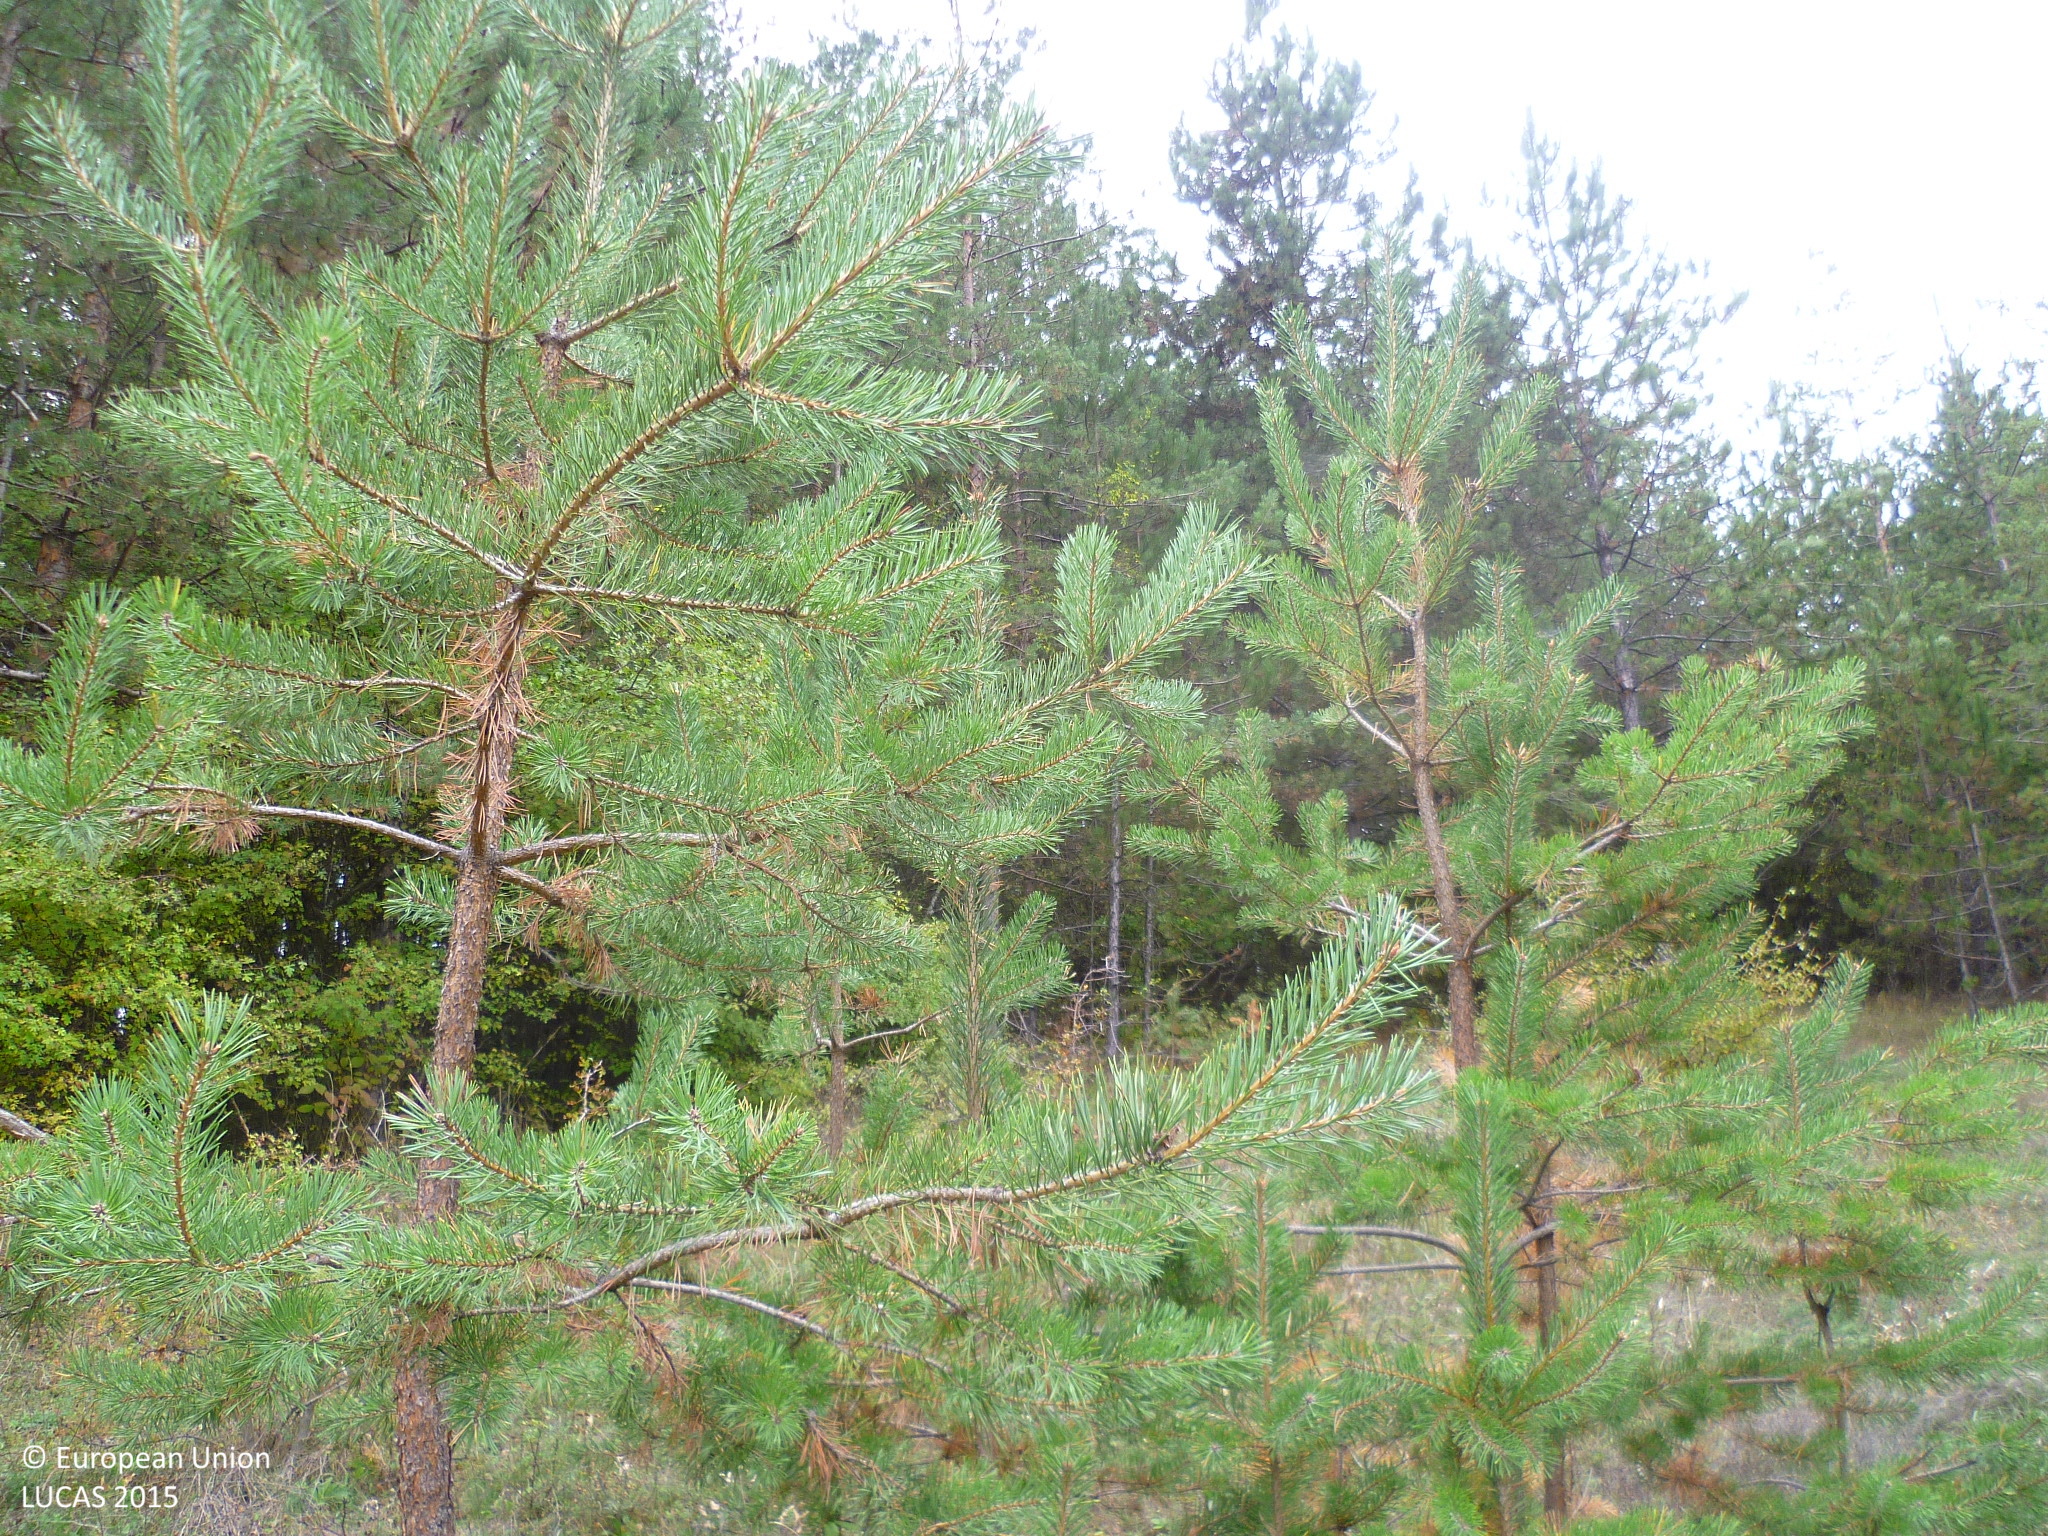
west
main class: Grassland
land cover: Grassland with sparse tree/shrub cover
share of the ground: > 75 %
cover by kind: herbaceous plants 90 %, coniferous forest trees 5 %, shrubs 5 %
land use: Agriculture (excluding fallow land and kitchen gardens)
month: October
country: BG
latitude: 42.8082
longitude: 22.7825
